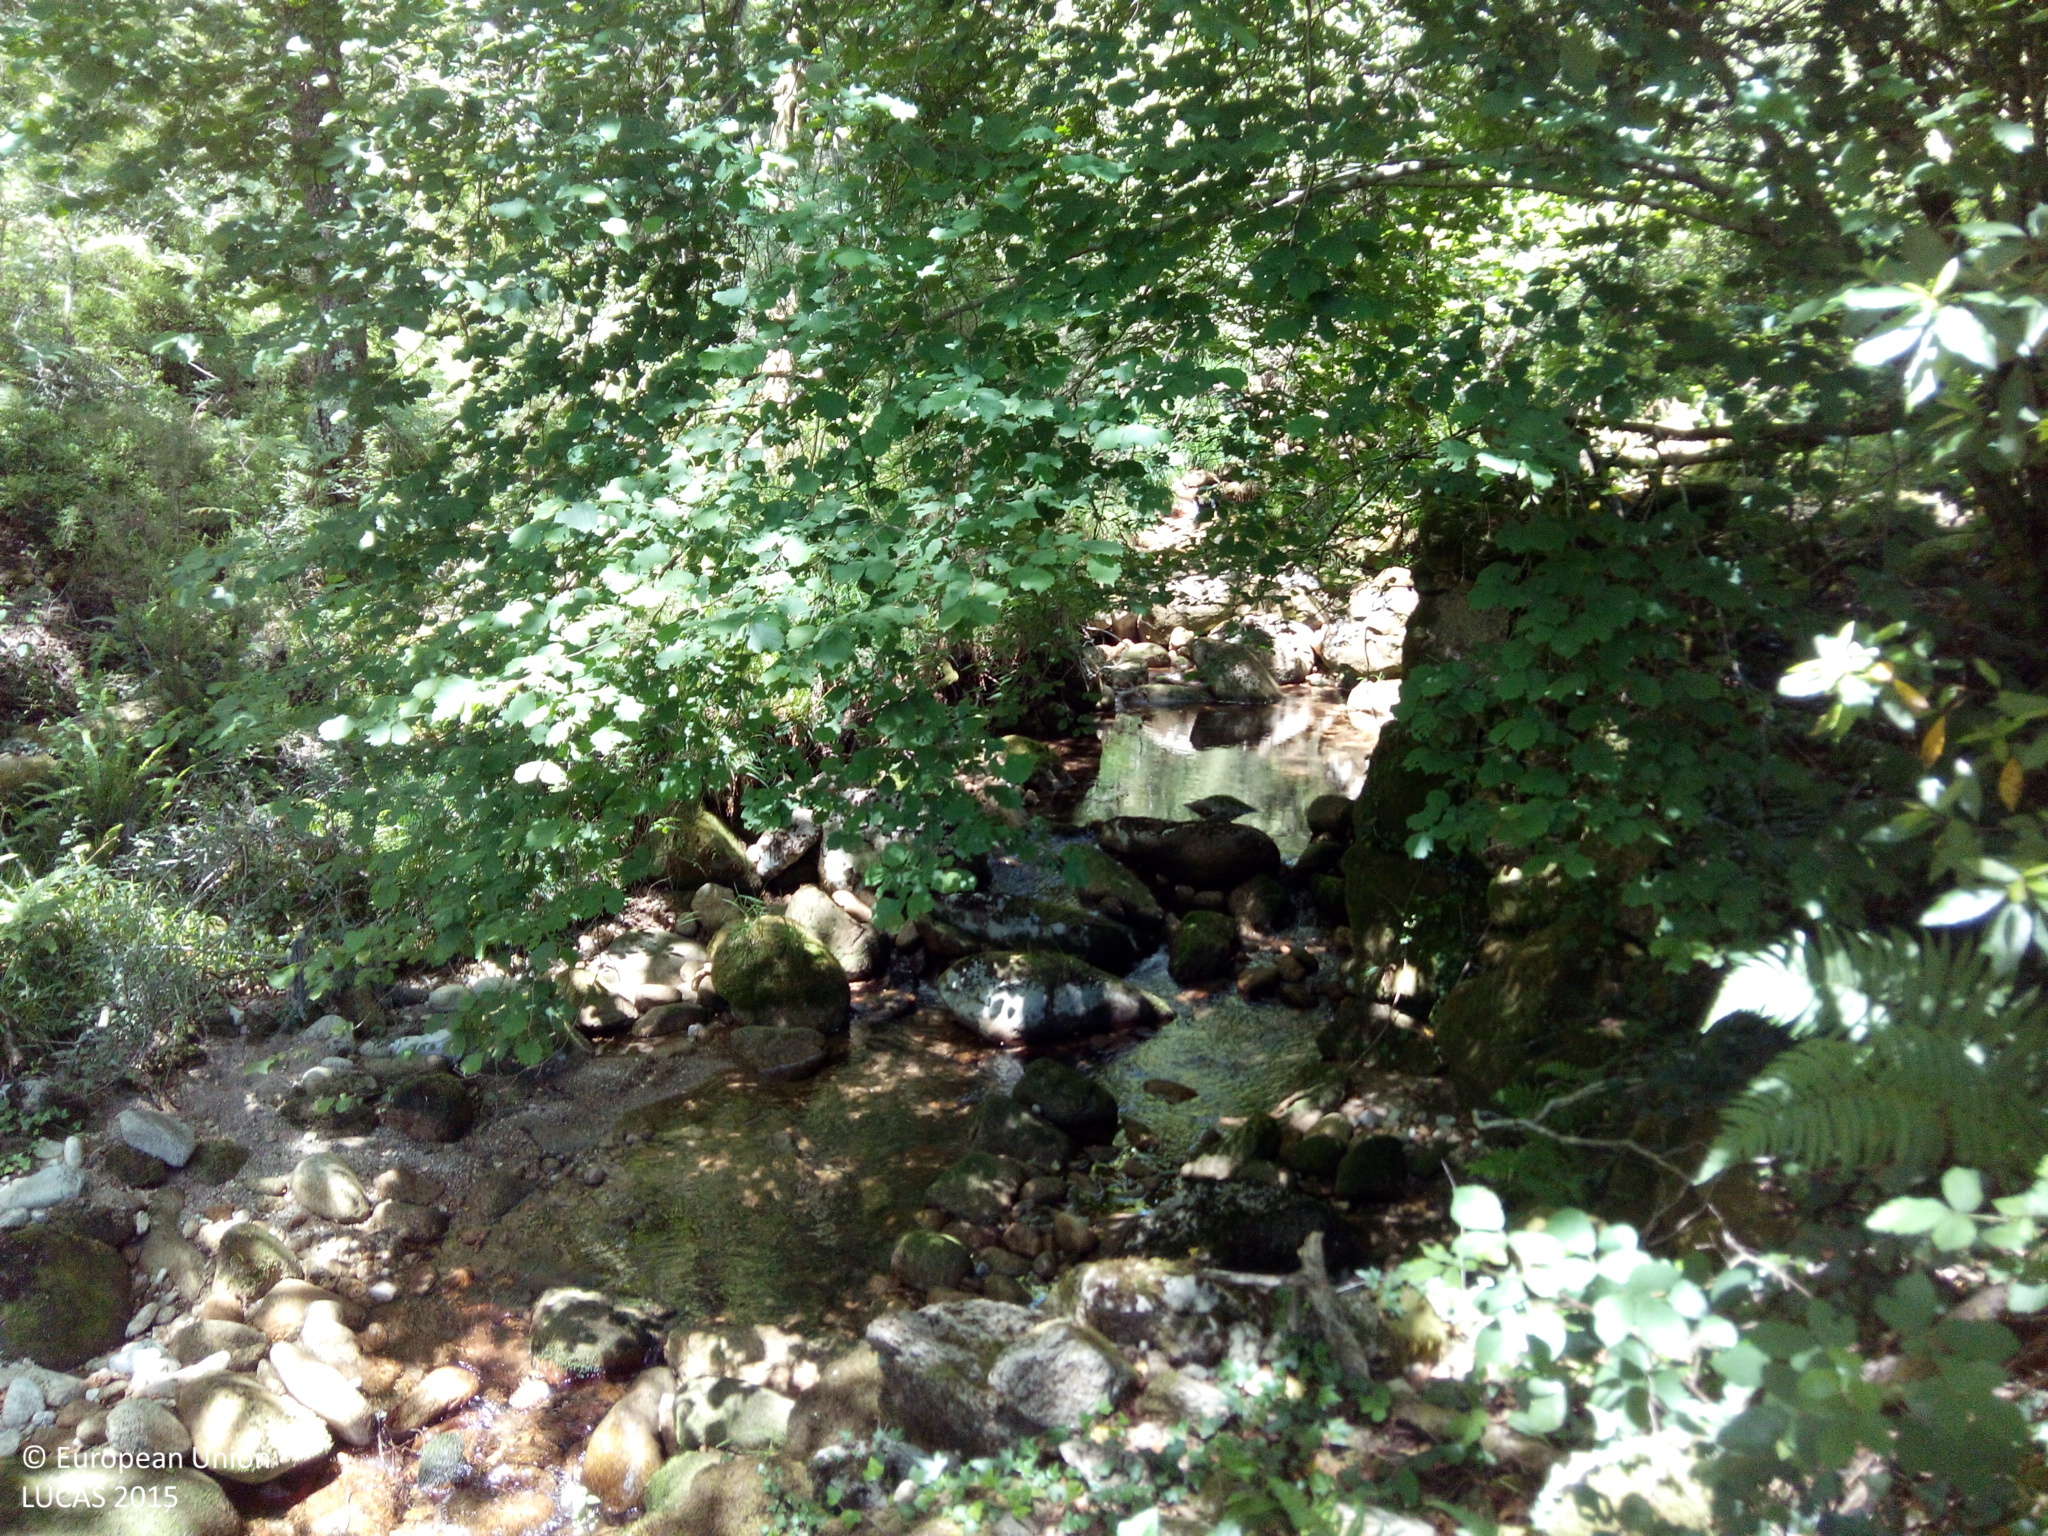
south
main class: Woodland
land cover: Broadleaved woodland
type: acidophilous oak and oak-birch forest
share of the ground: > 75 %
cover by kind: broadleaved forest trees 100 %
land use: Forestry
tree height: > 5 m
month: June
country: ES
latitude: 42.4618
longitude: -8.4221
